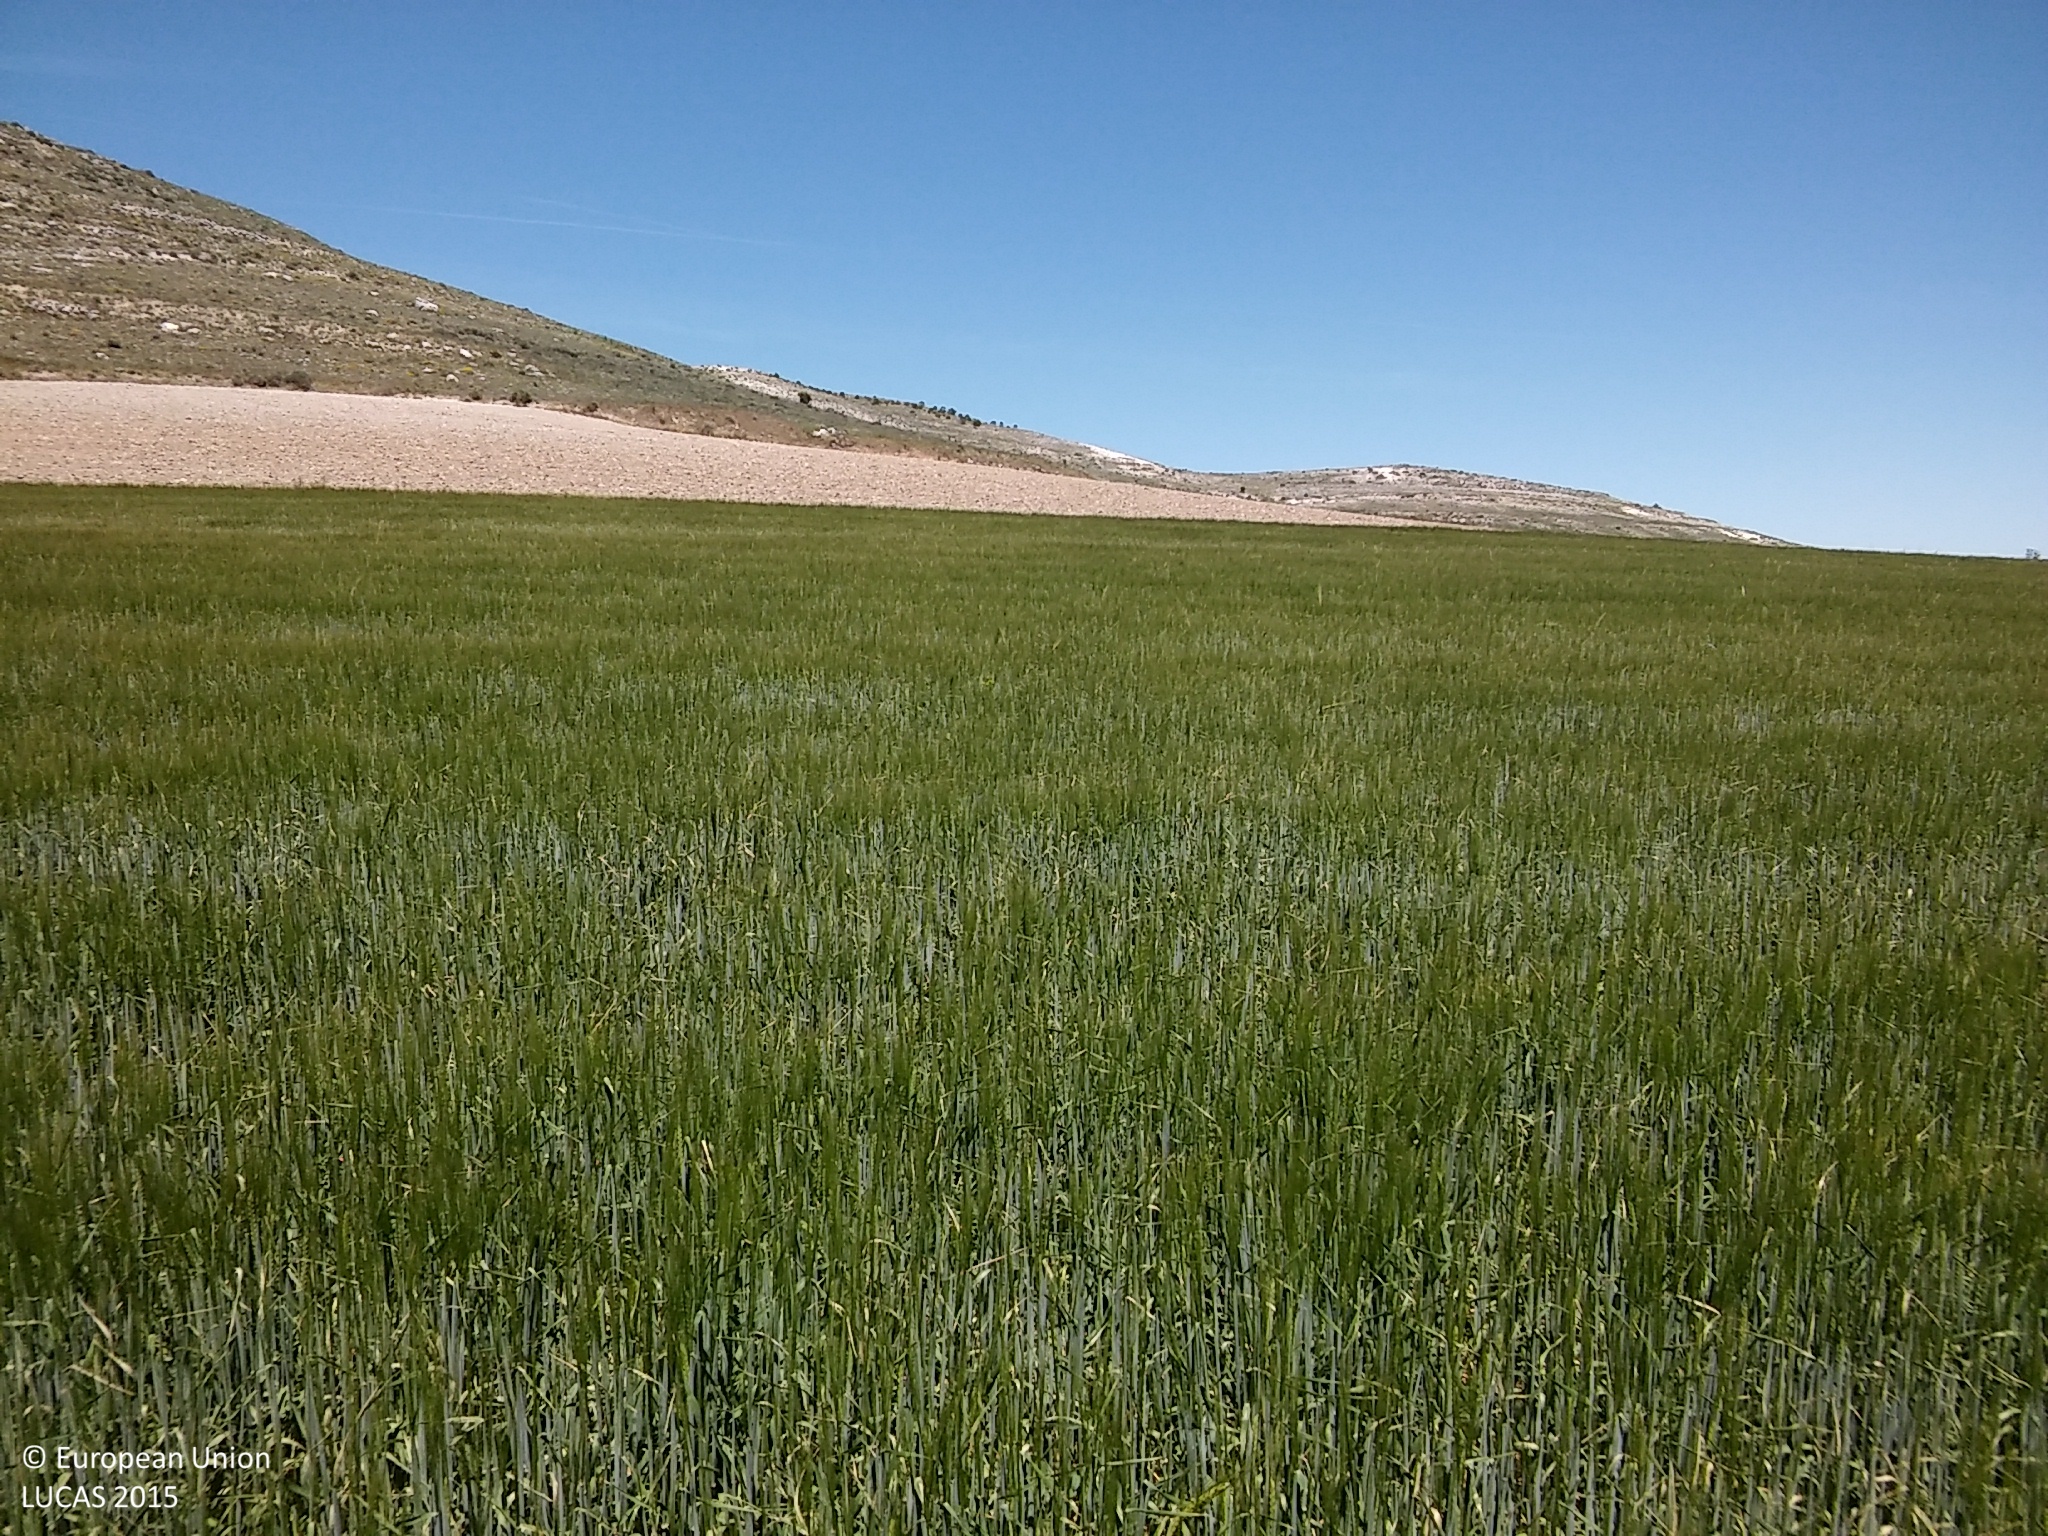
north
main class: Cropland
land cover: Barley
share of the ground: > 75 %
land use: Agriculture (excluding fallow land and kitchen gardens)
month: May
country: ES
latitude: 41.4774
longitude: -3.9821
